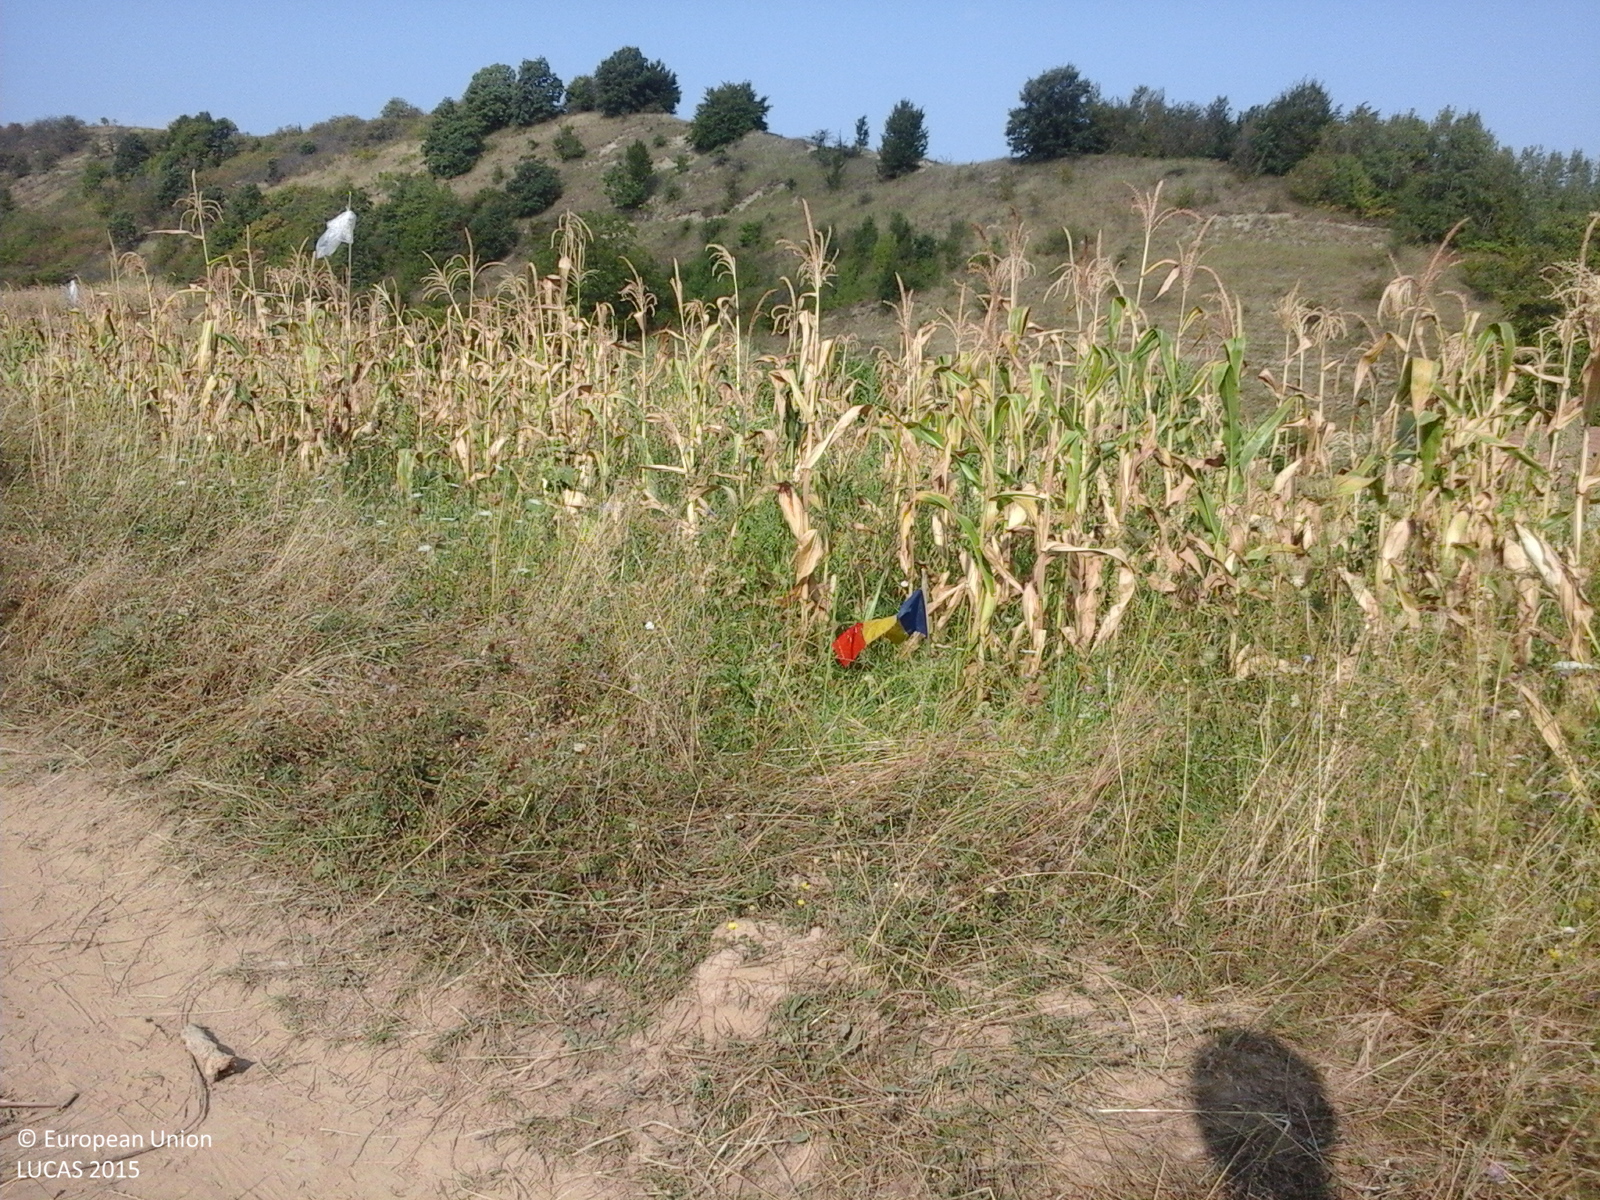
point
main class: Cropland
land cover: Maize
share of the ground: > 75 %
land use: Agriculture (excluding fallow land and kitchen gardens)
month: September
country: RO
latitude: 47.1009
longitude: 24.0348
